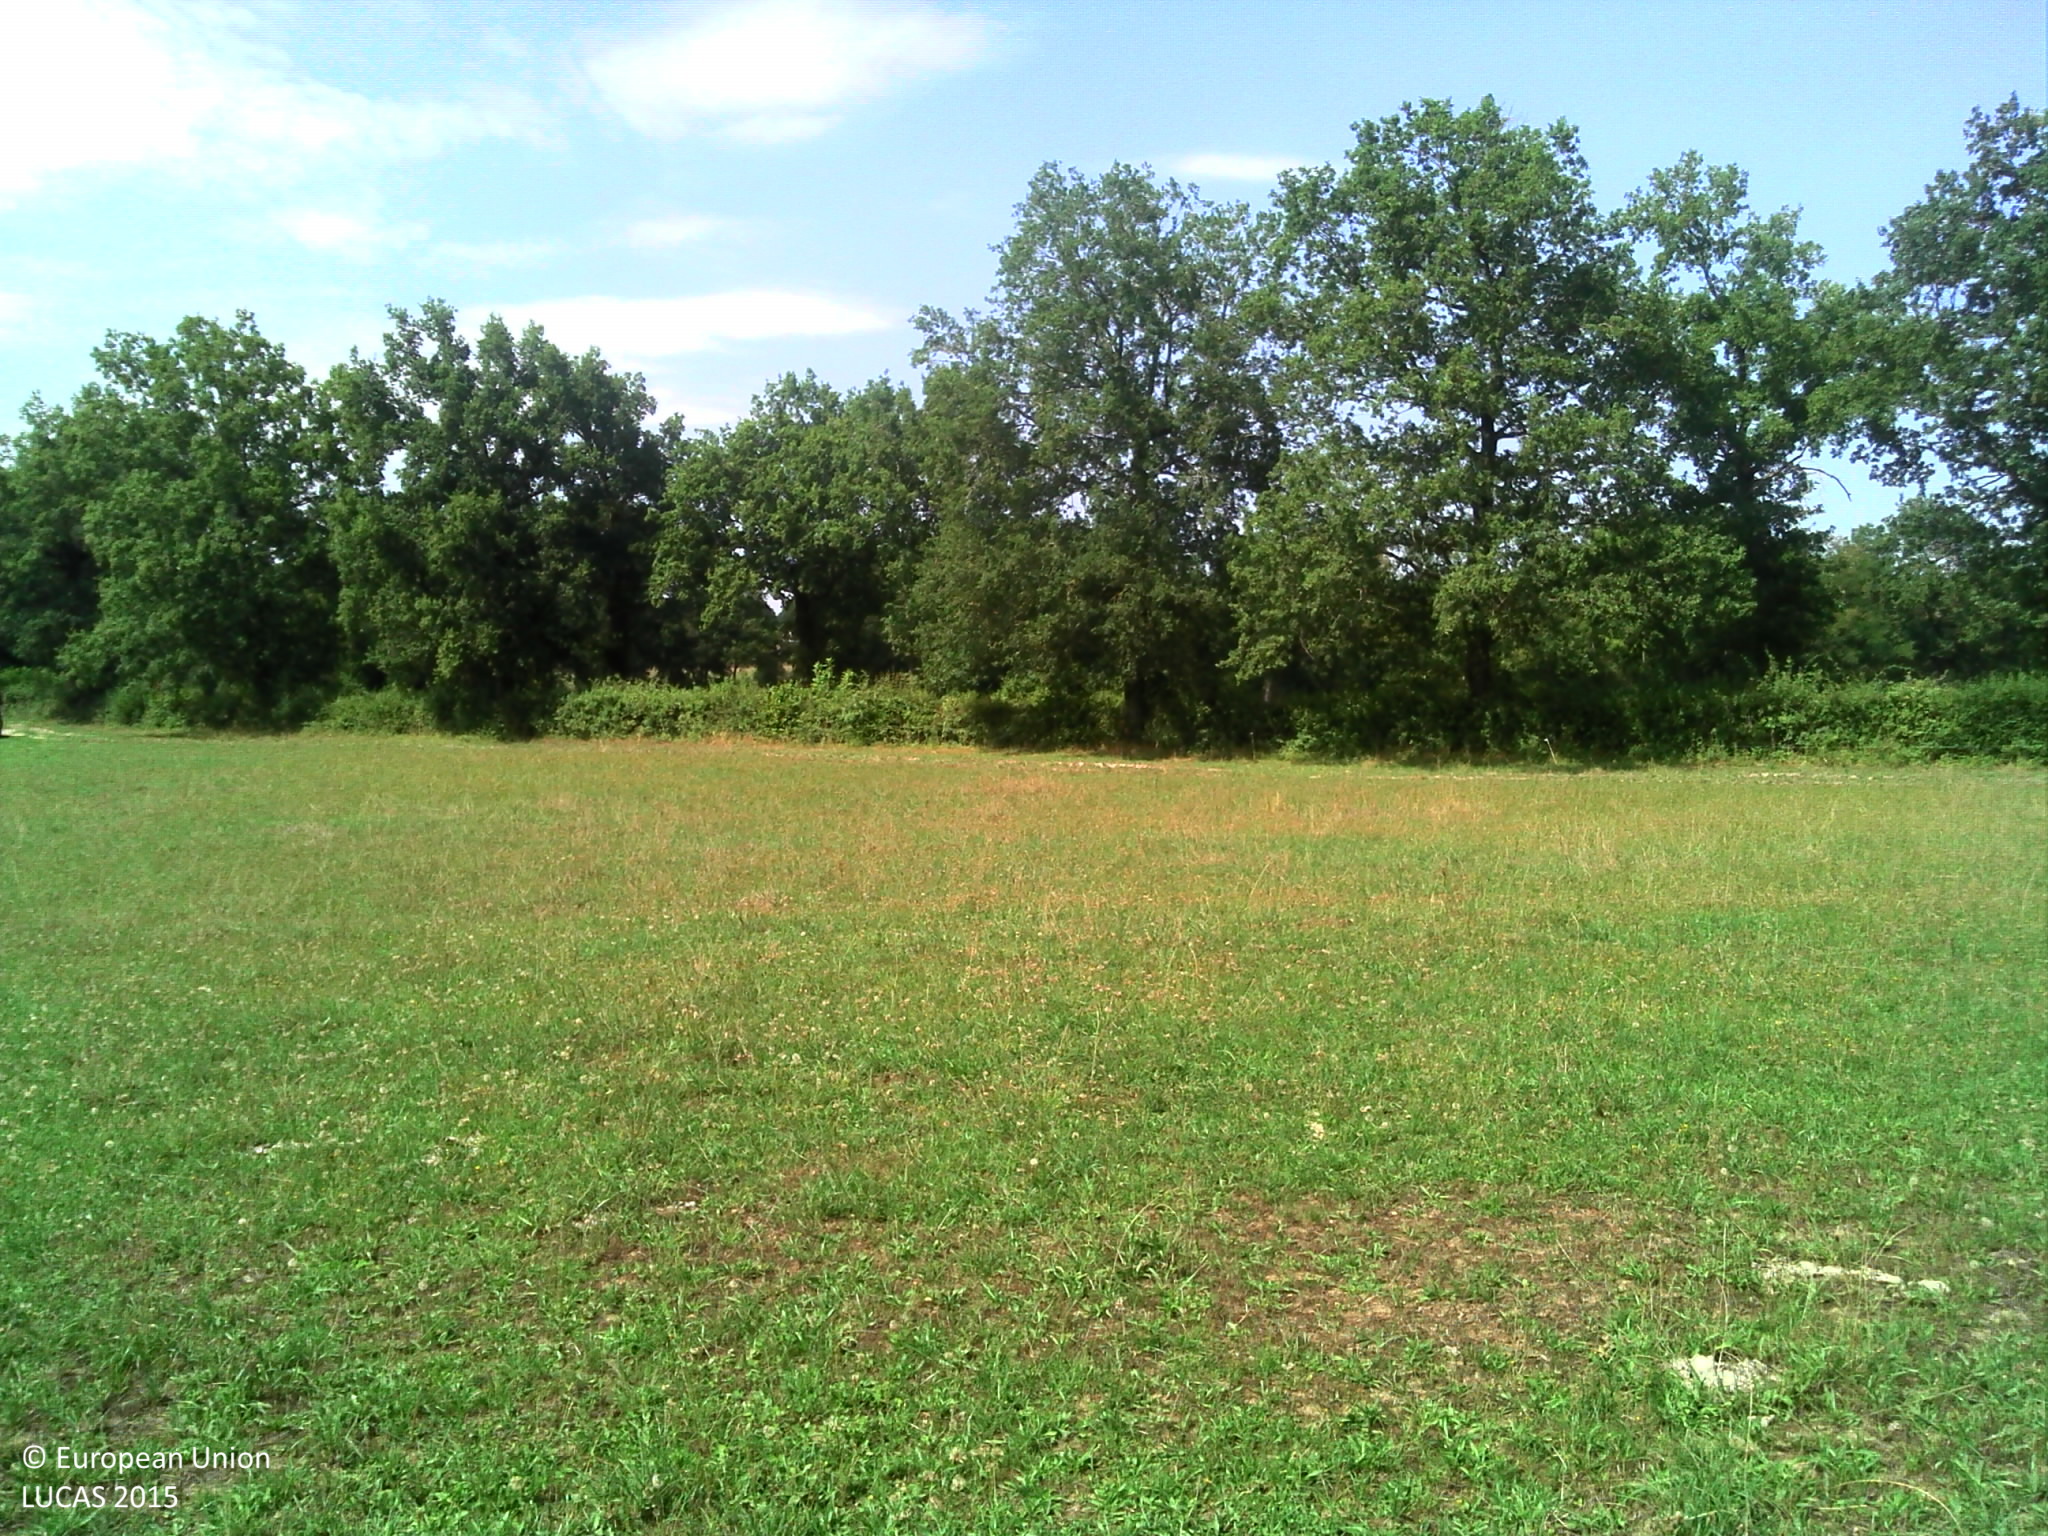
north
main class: Grassland
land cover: Grassland without tree/shrub cover
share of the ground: > 75 %
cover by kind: herbaceous plants 100 %
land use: Agriculture (excluding fallow land and kitchen gardens)
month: August
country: FR
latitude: 46.2328
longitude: 2.2535
